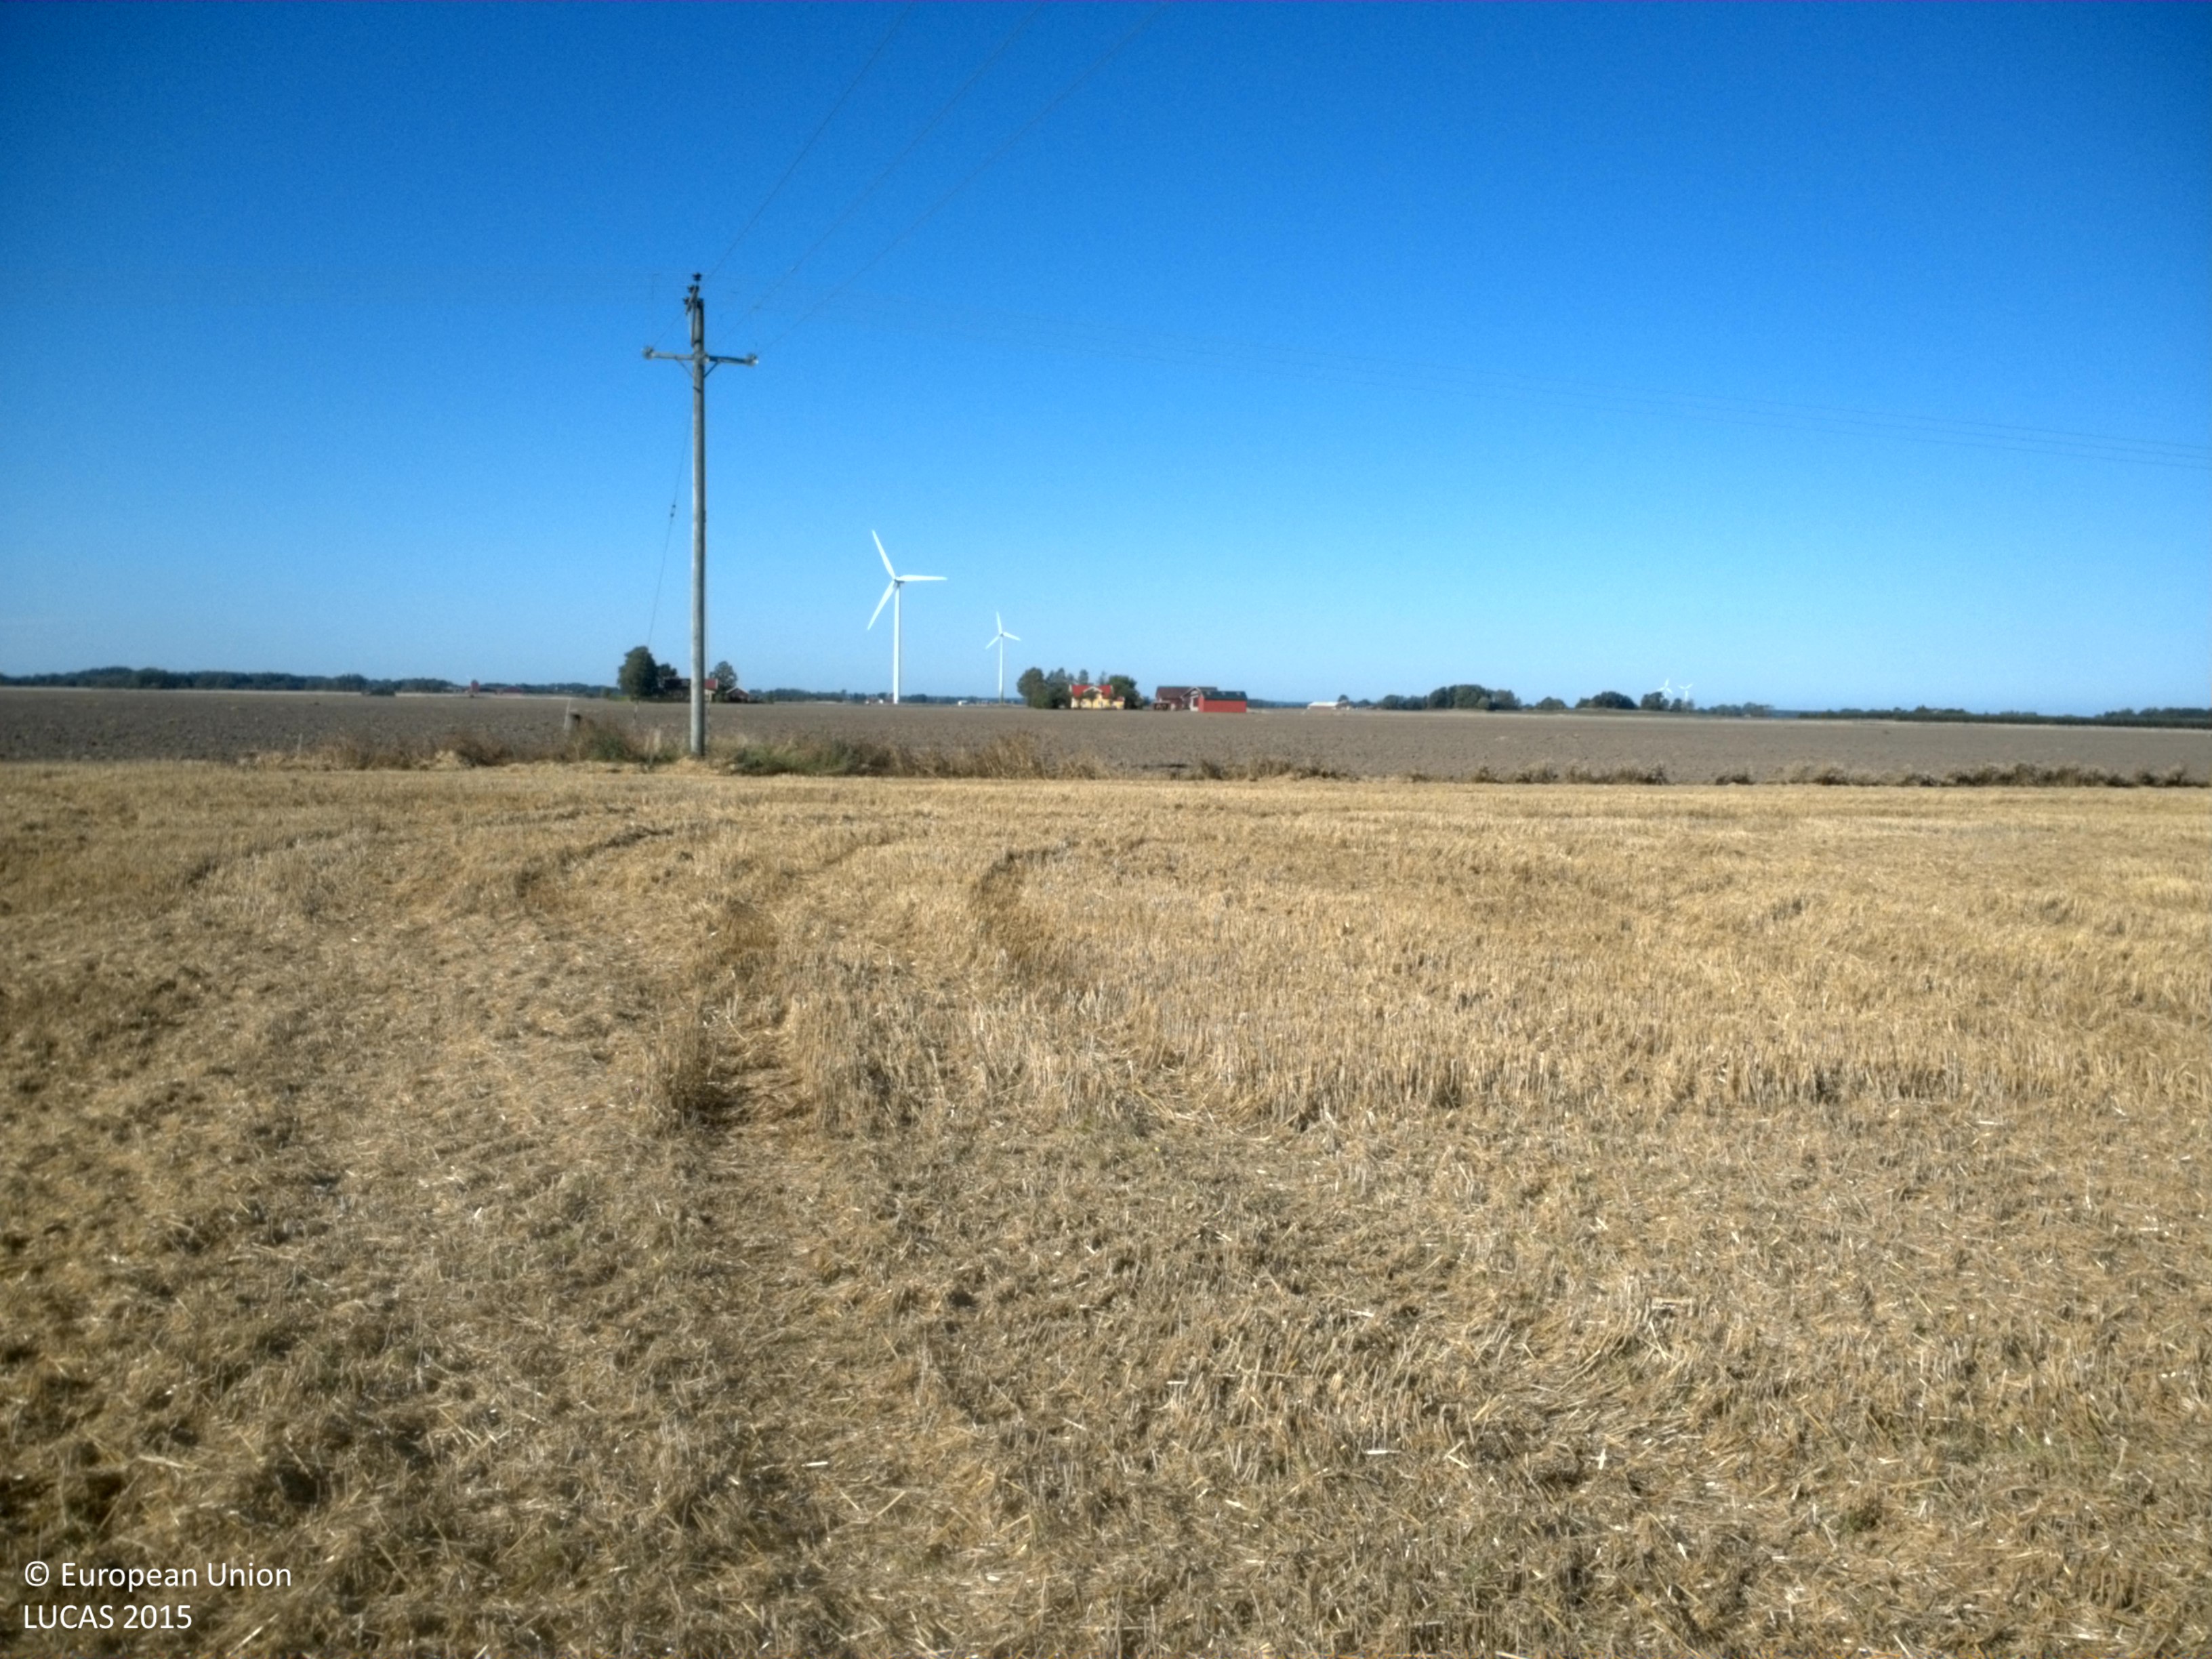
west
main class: Cropland
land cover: Common wheat
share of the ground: 50 - 75 %
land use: Agriculture (excluding fallow land and kitchen gardens)
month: September
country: SE
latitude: 58.3968
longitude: 13.2279
